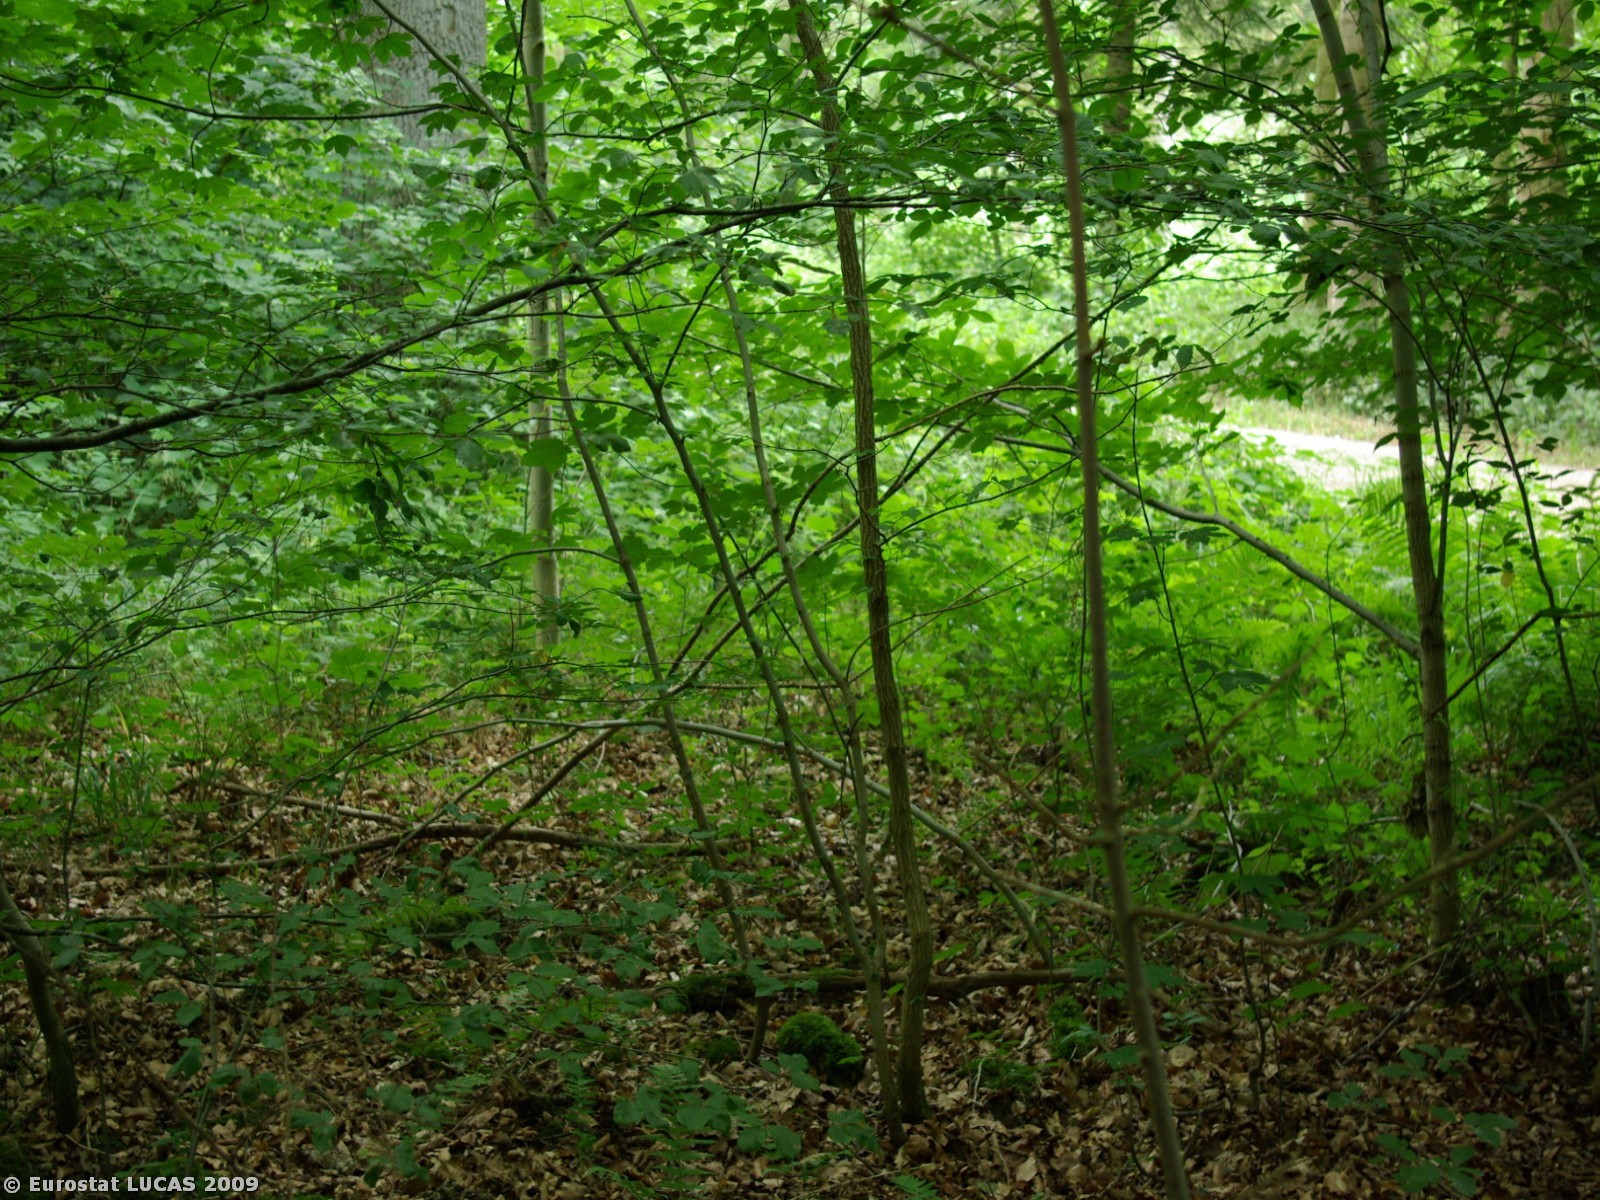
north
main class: Woodland
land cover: Broadleaved woodland
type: mesophytic deciduous forest
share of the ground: > 75 %
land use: Forestry
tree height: > 5 m
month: July
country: DK
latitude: 55.0194
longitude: 9.8906
